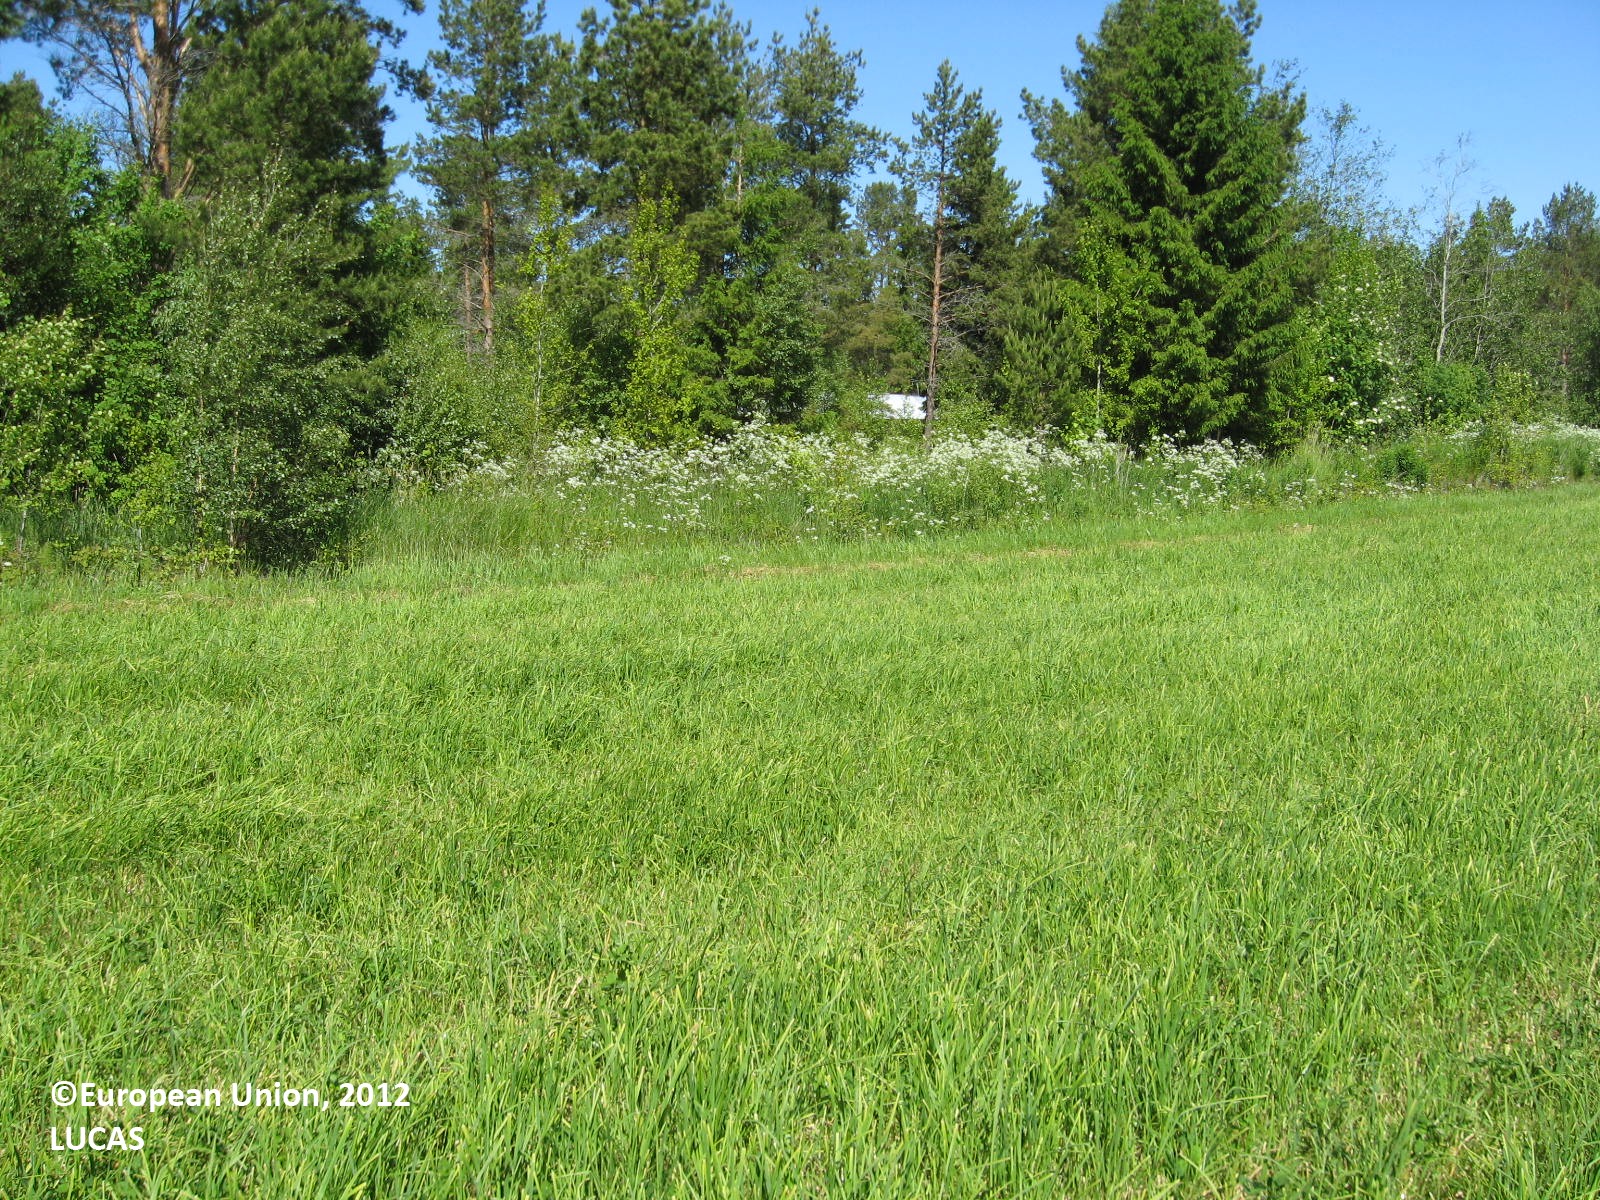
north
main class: Cropland
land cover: Other leguminous and mixtures for fodder
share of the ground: > 75 %
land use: Agriculture (excluding fallow land and kitchen gardens)
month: June
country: FI
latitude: 62.7901
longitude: 21.2713
